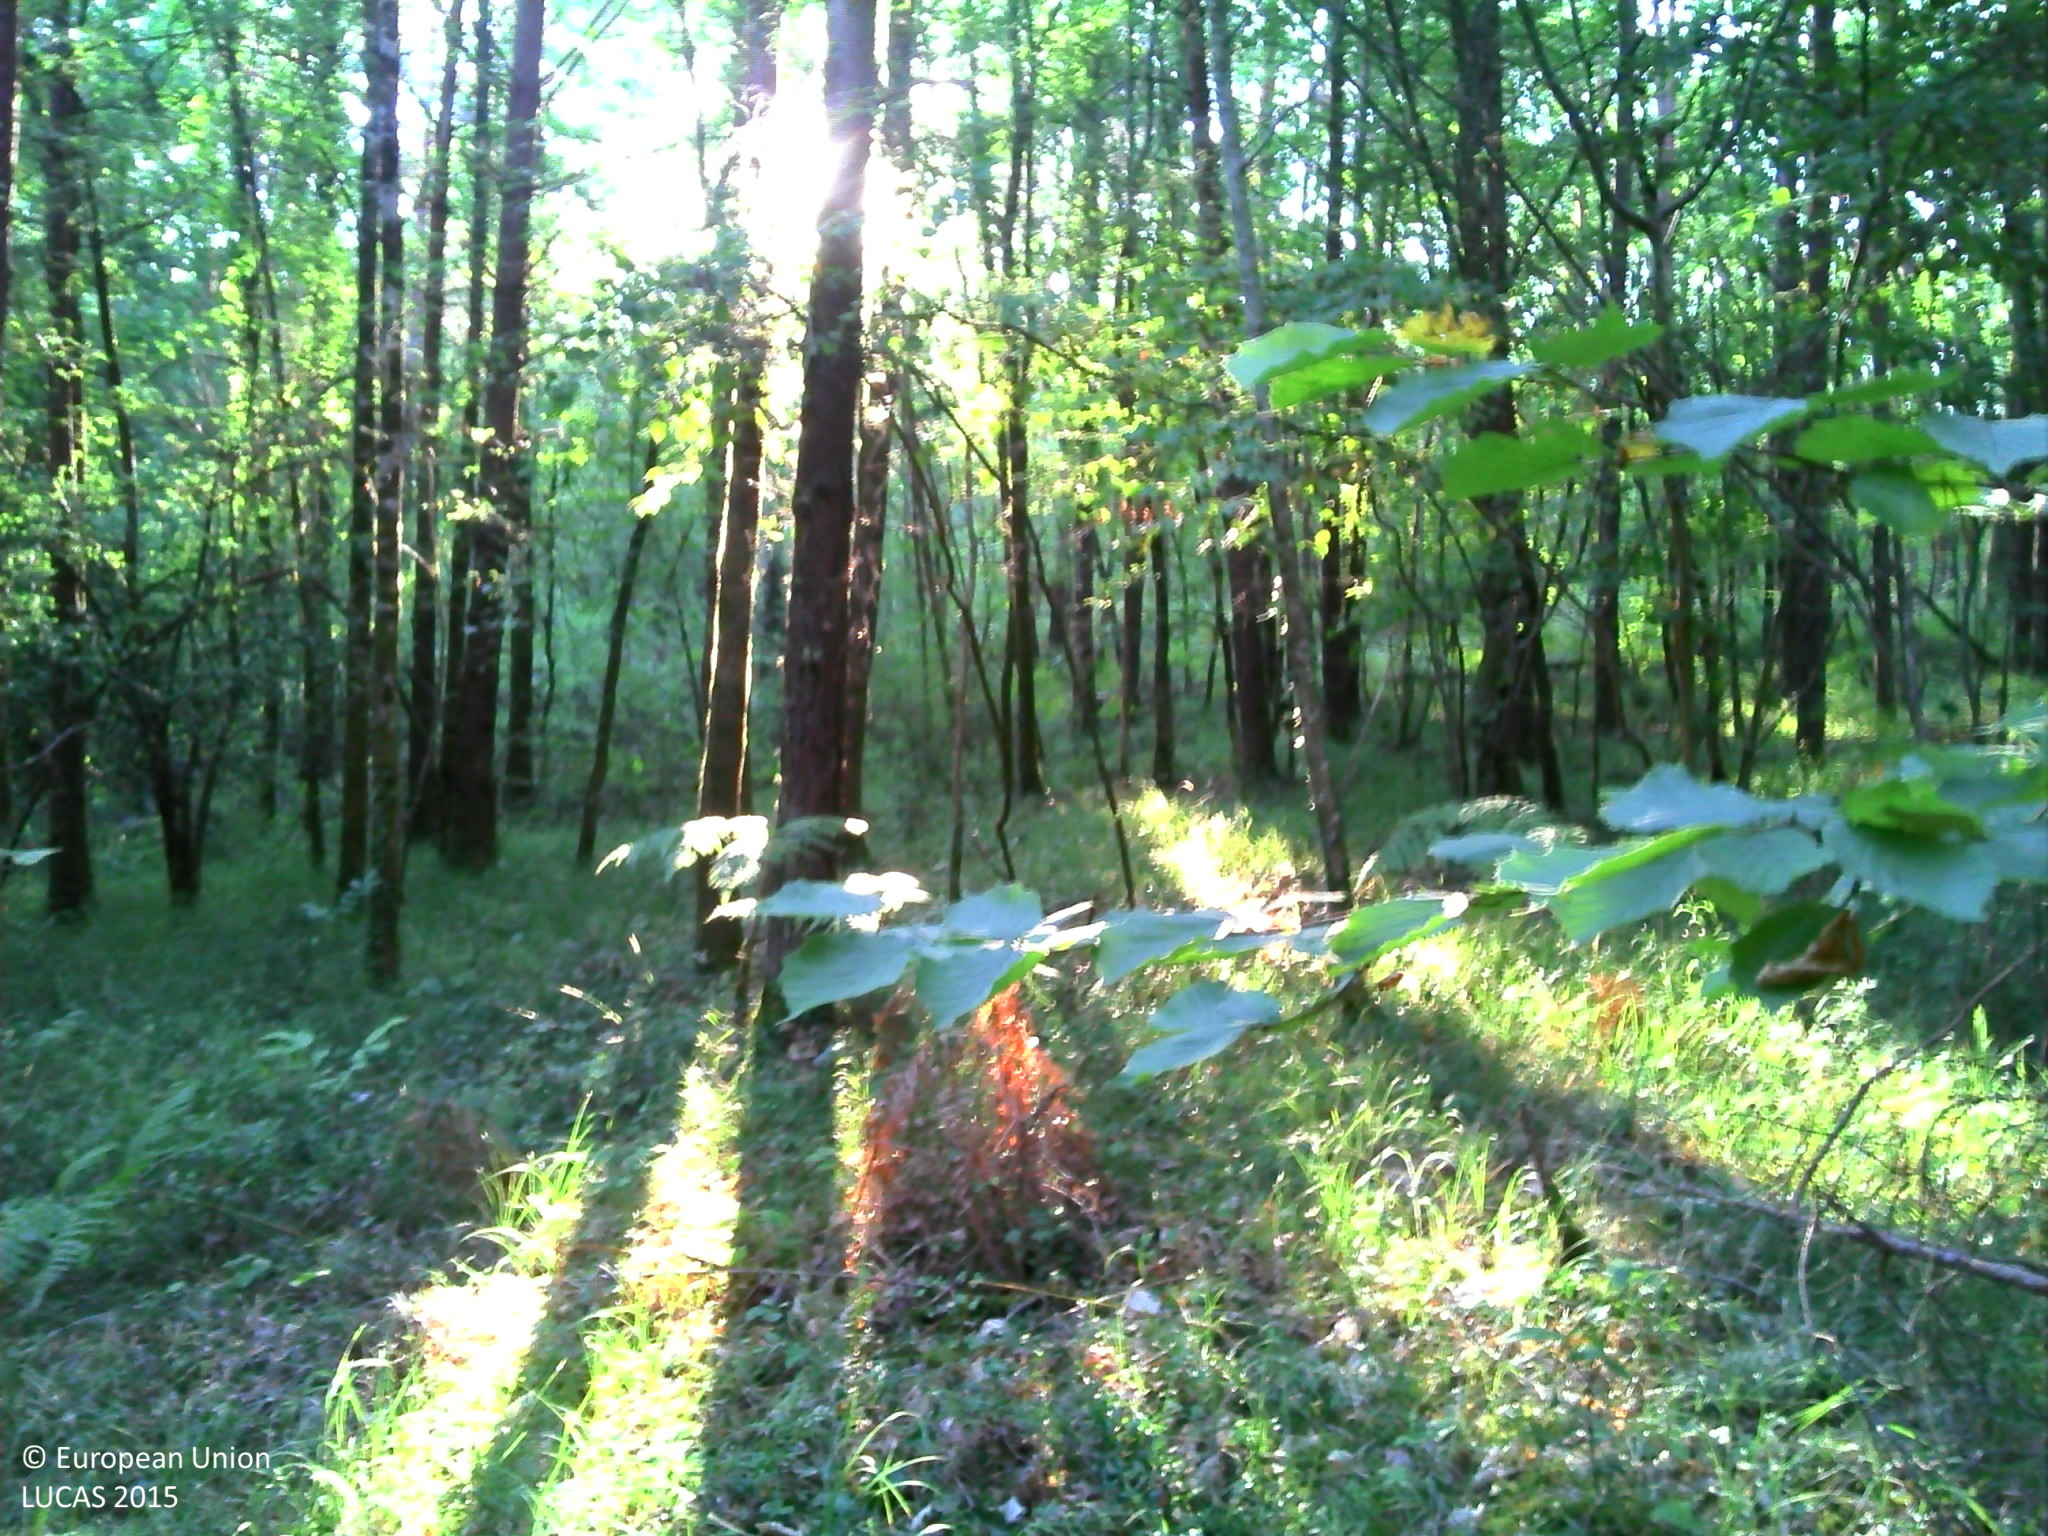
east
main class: Woodland
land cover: Pine dominated mixed woodland
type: mesophytic deciduous forest
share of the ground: > 75 %
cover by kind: broadleaved forest trees 60 %, coniferous forest trees 20 %, herbaceous plants 10 %, shrubs 5 %, lichens and mosses 5 %
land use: Forestry
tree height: > 5 m
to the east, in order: Pine dominated mixed woodland; Electric lines; Paved roads, cycling and walking lanes; Broadleaved woodland; Tracks; Broadleaved woodland
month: August
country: FR
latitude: 44.8297
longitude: 0.7970
